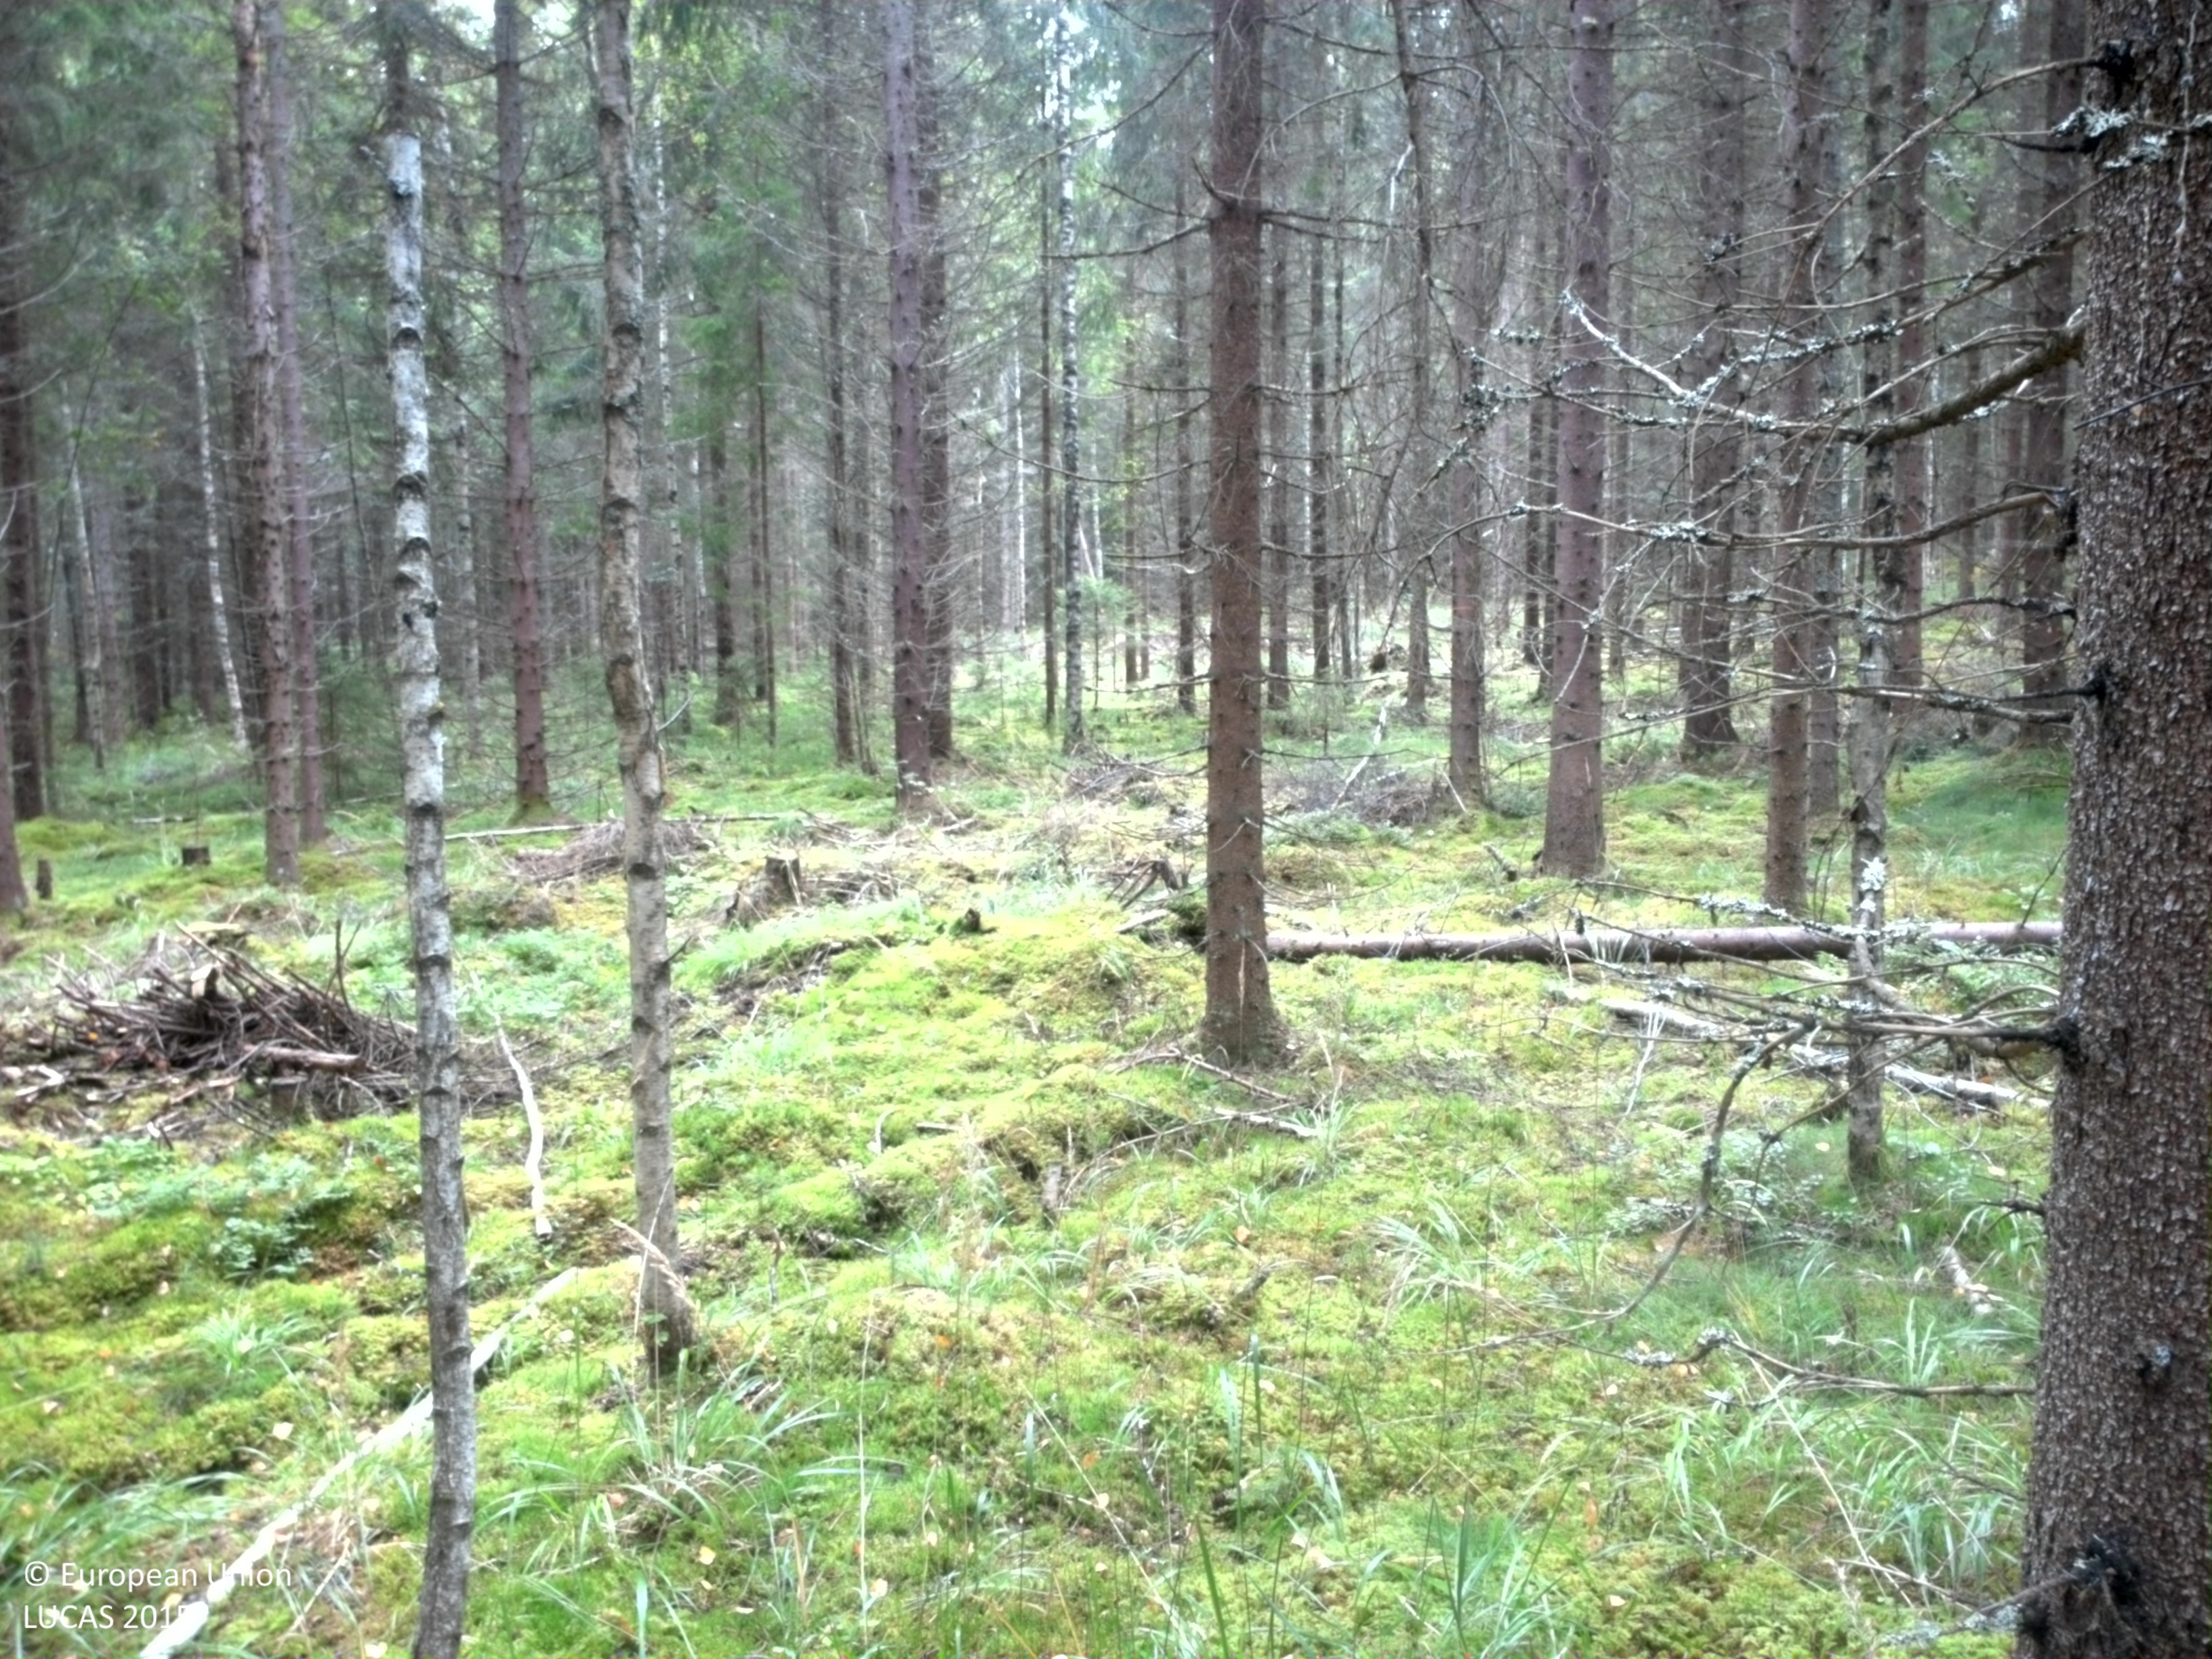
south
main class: Woodland
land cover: Spruce dominated coniferous woodland
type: boreal forest
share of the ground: 50 - 75 %
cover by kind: coniferous forest trees 65 %, lichens and mosses 20 %, broadleaved forest trees 5 %, shrubs 5 %, herbaceous plants 5 %
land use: Forestry
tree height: > 5 m
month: August
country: SE
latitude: 59.6717
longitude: 13.3828
